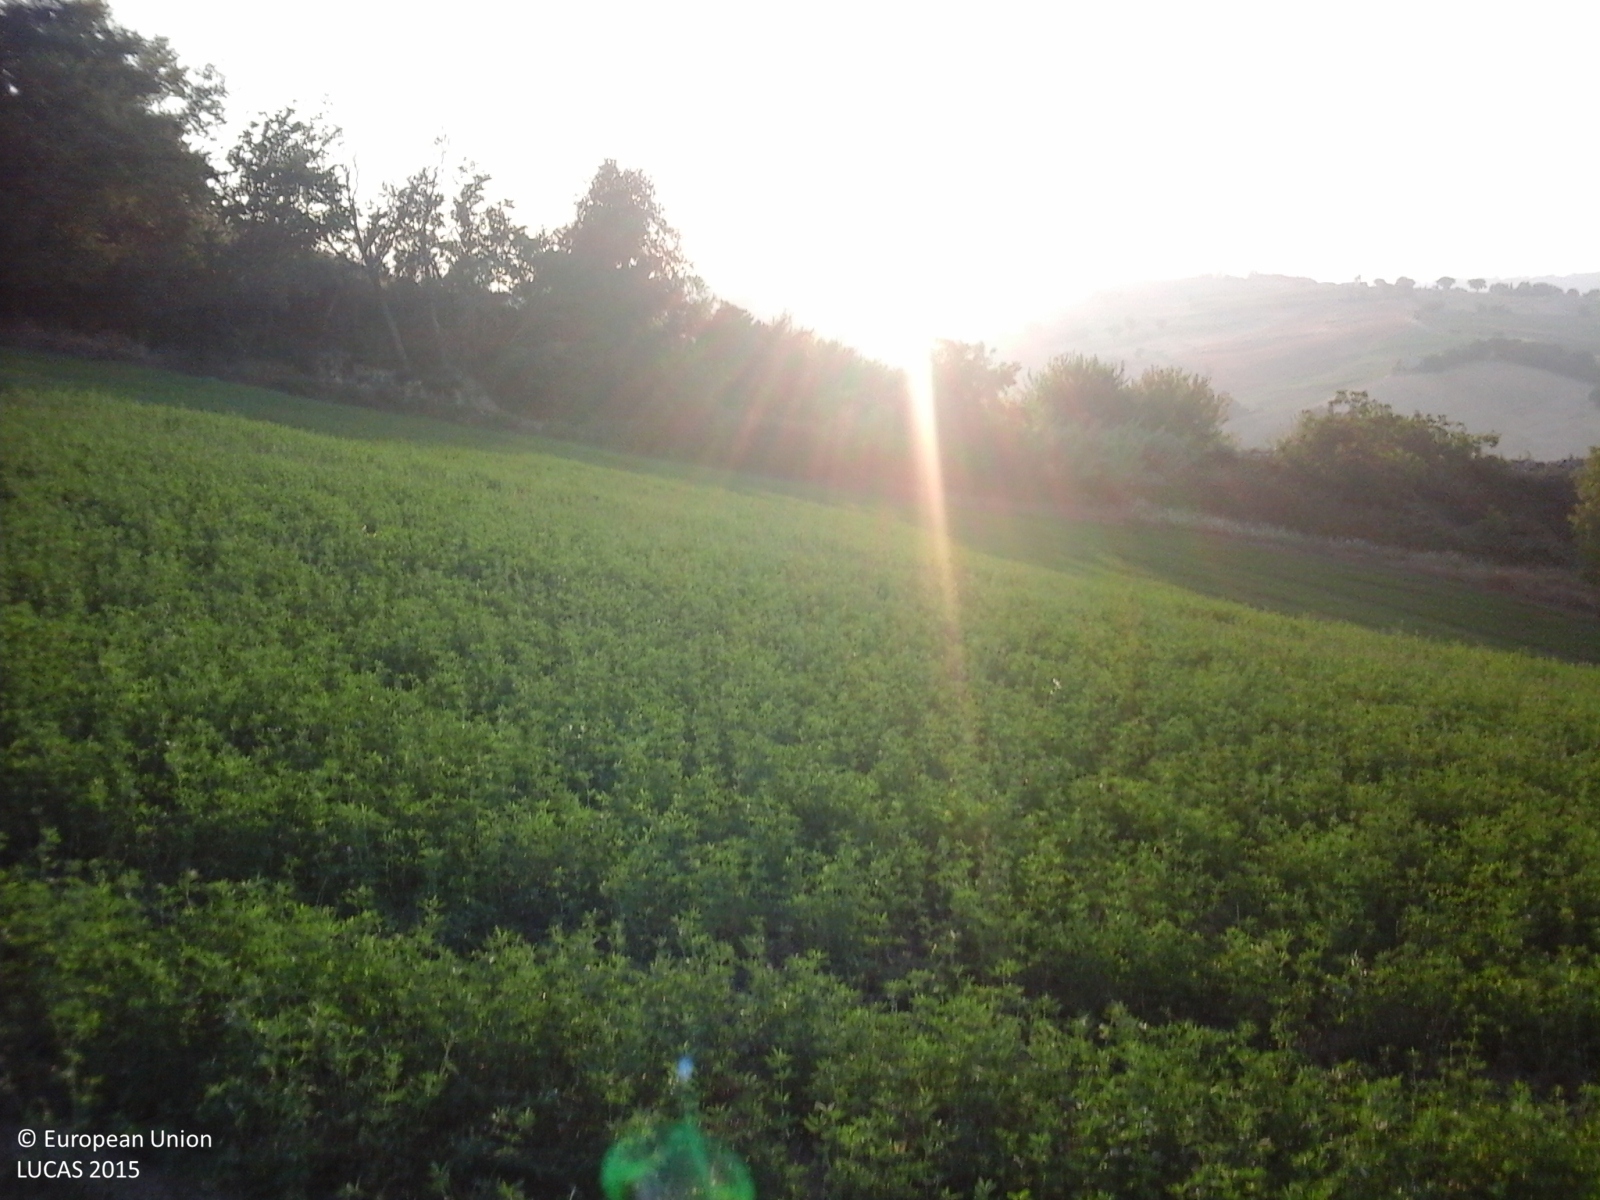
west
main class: Cropland
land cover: Lucerne
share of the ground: > 75 %
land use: Agriculture (excluding fallow land and kitchen gardens)
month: August
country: IT
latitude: 43.1376
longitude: 13.4455
